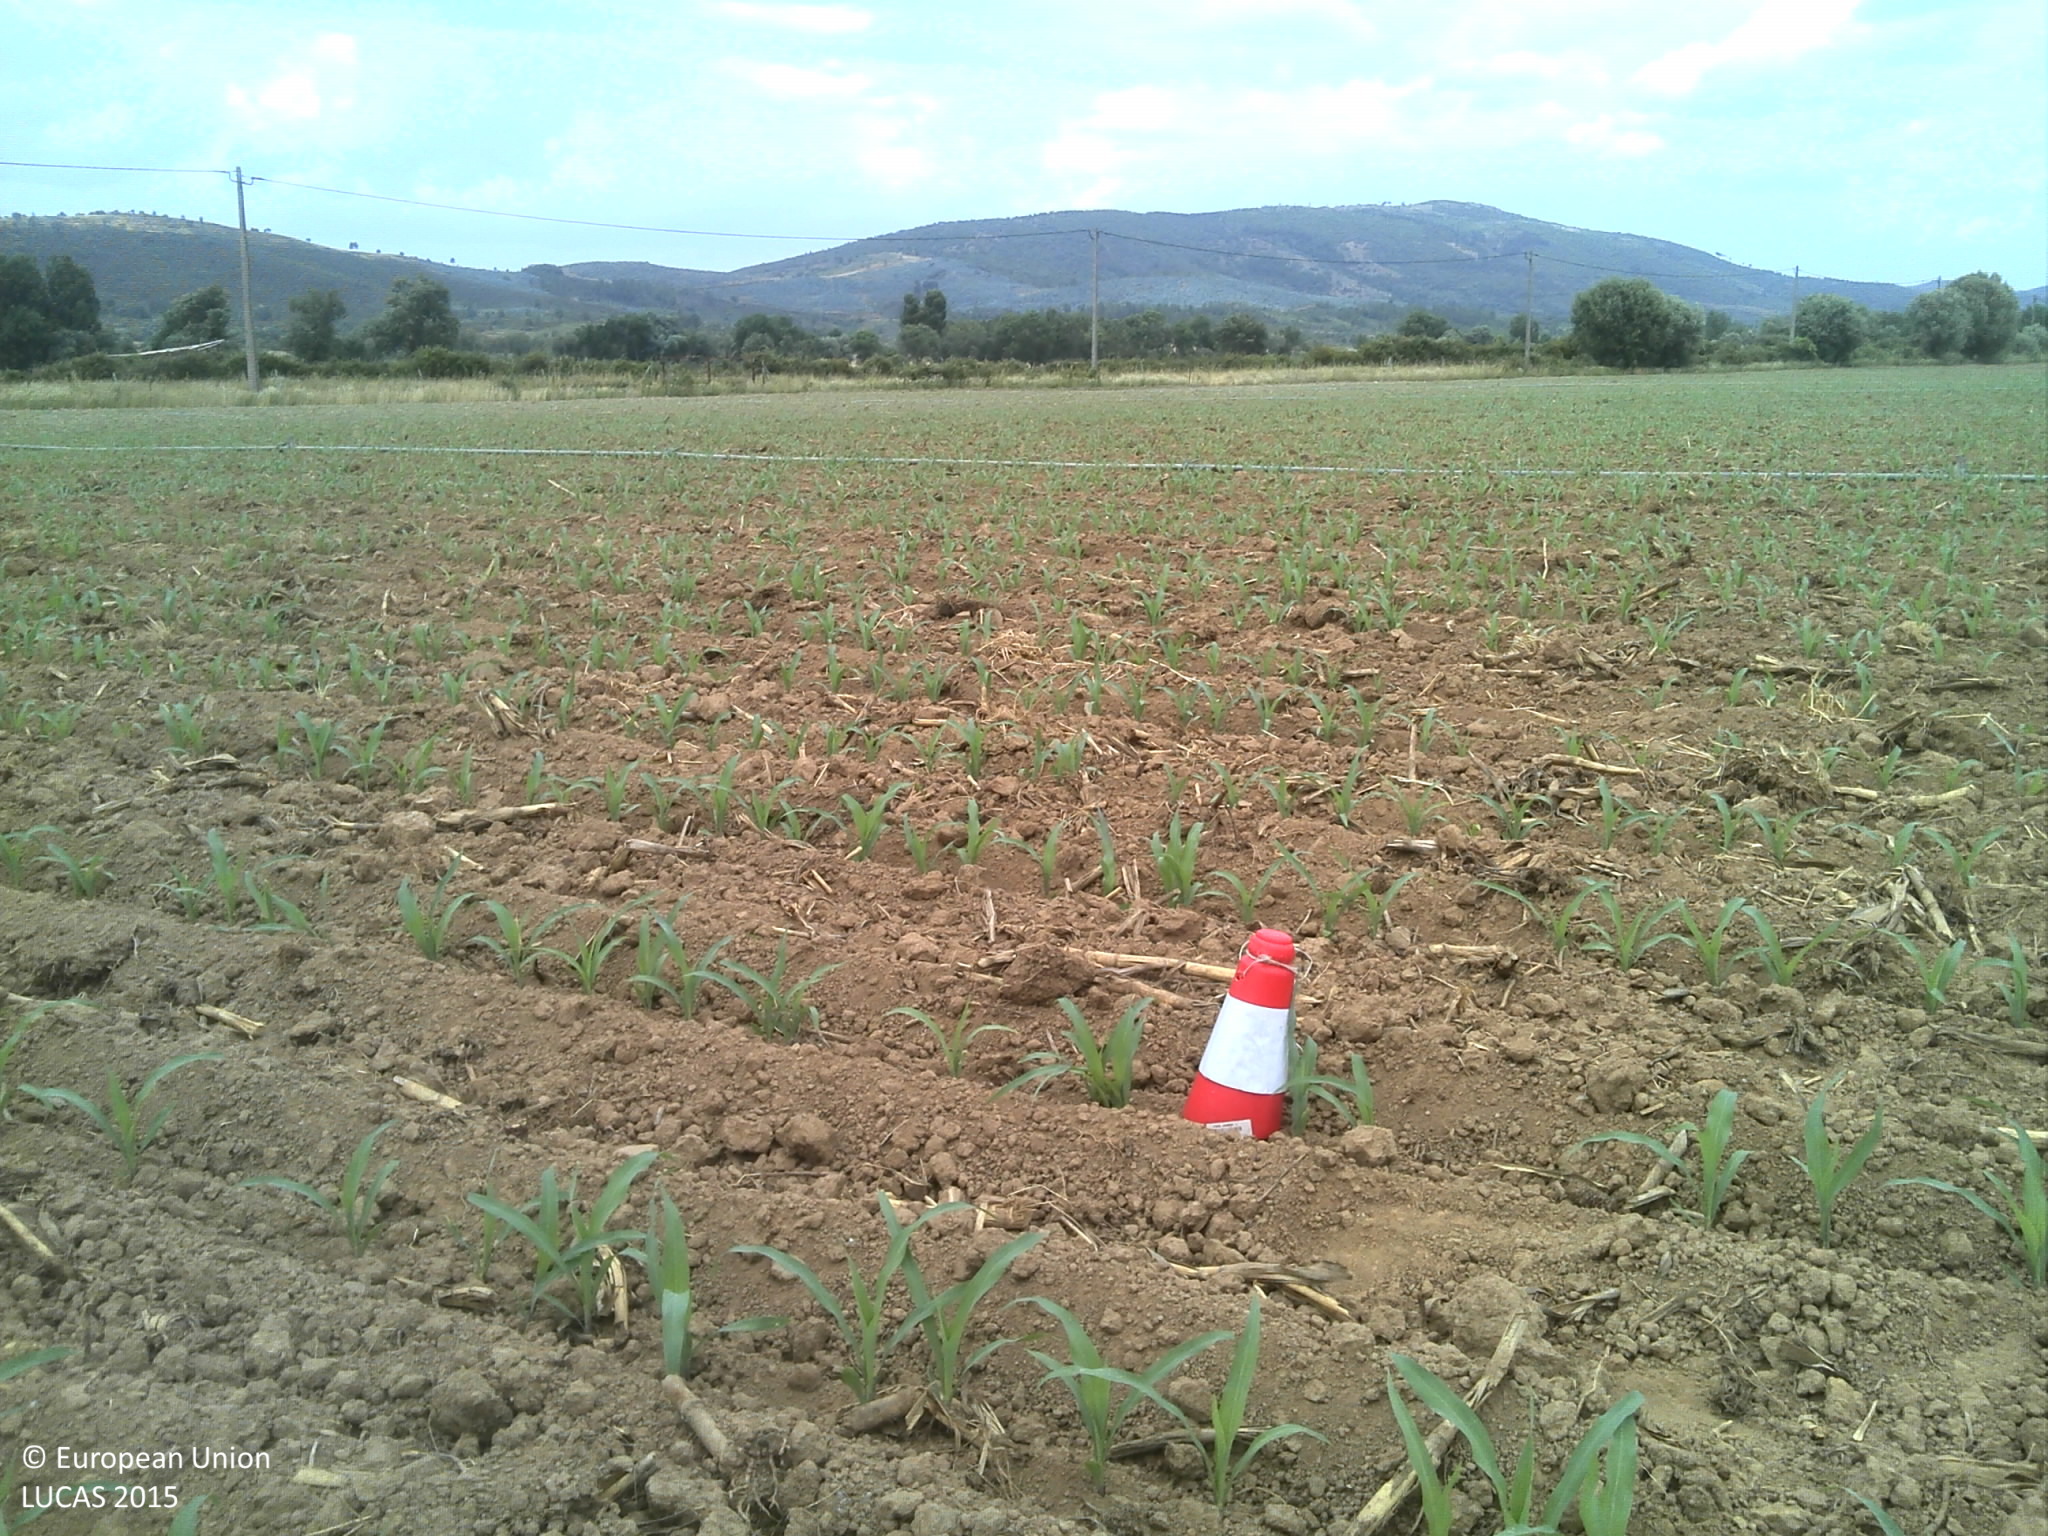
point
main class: Cropland
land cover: Maize
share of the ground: < 10 %
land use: Agriculture (excluding fallow land and kitchen gardens)
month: June
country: PT
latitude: 40.2431
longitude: -7.2270
